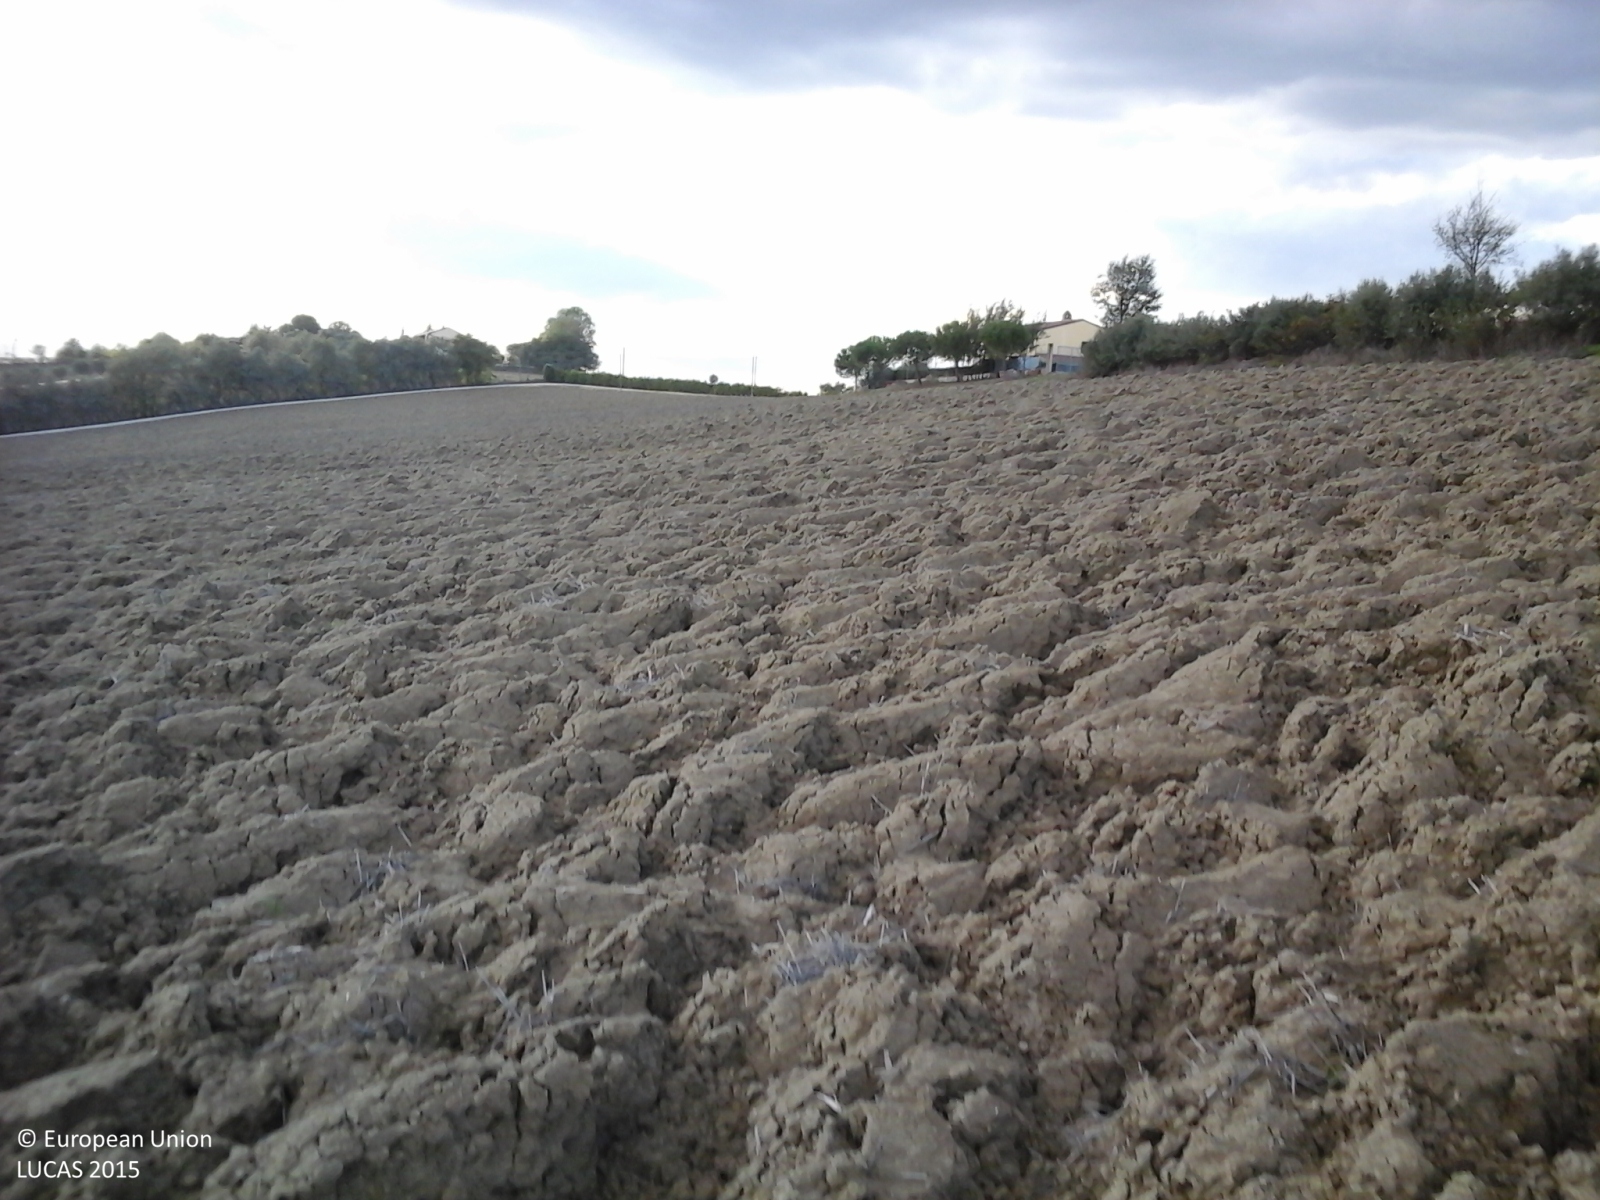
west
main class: Cropland
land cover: Durum wheat
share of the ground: < 10 %
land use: Agriculture (excluding fallow land and kitchen gardens)
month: October
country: IT
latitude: 43.5383
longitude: 13.3456
